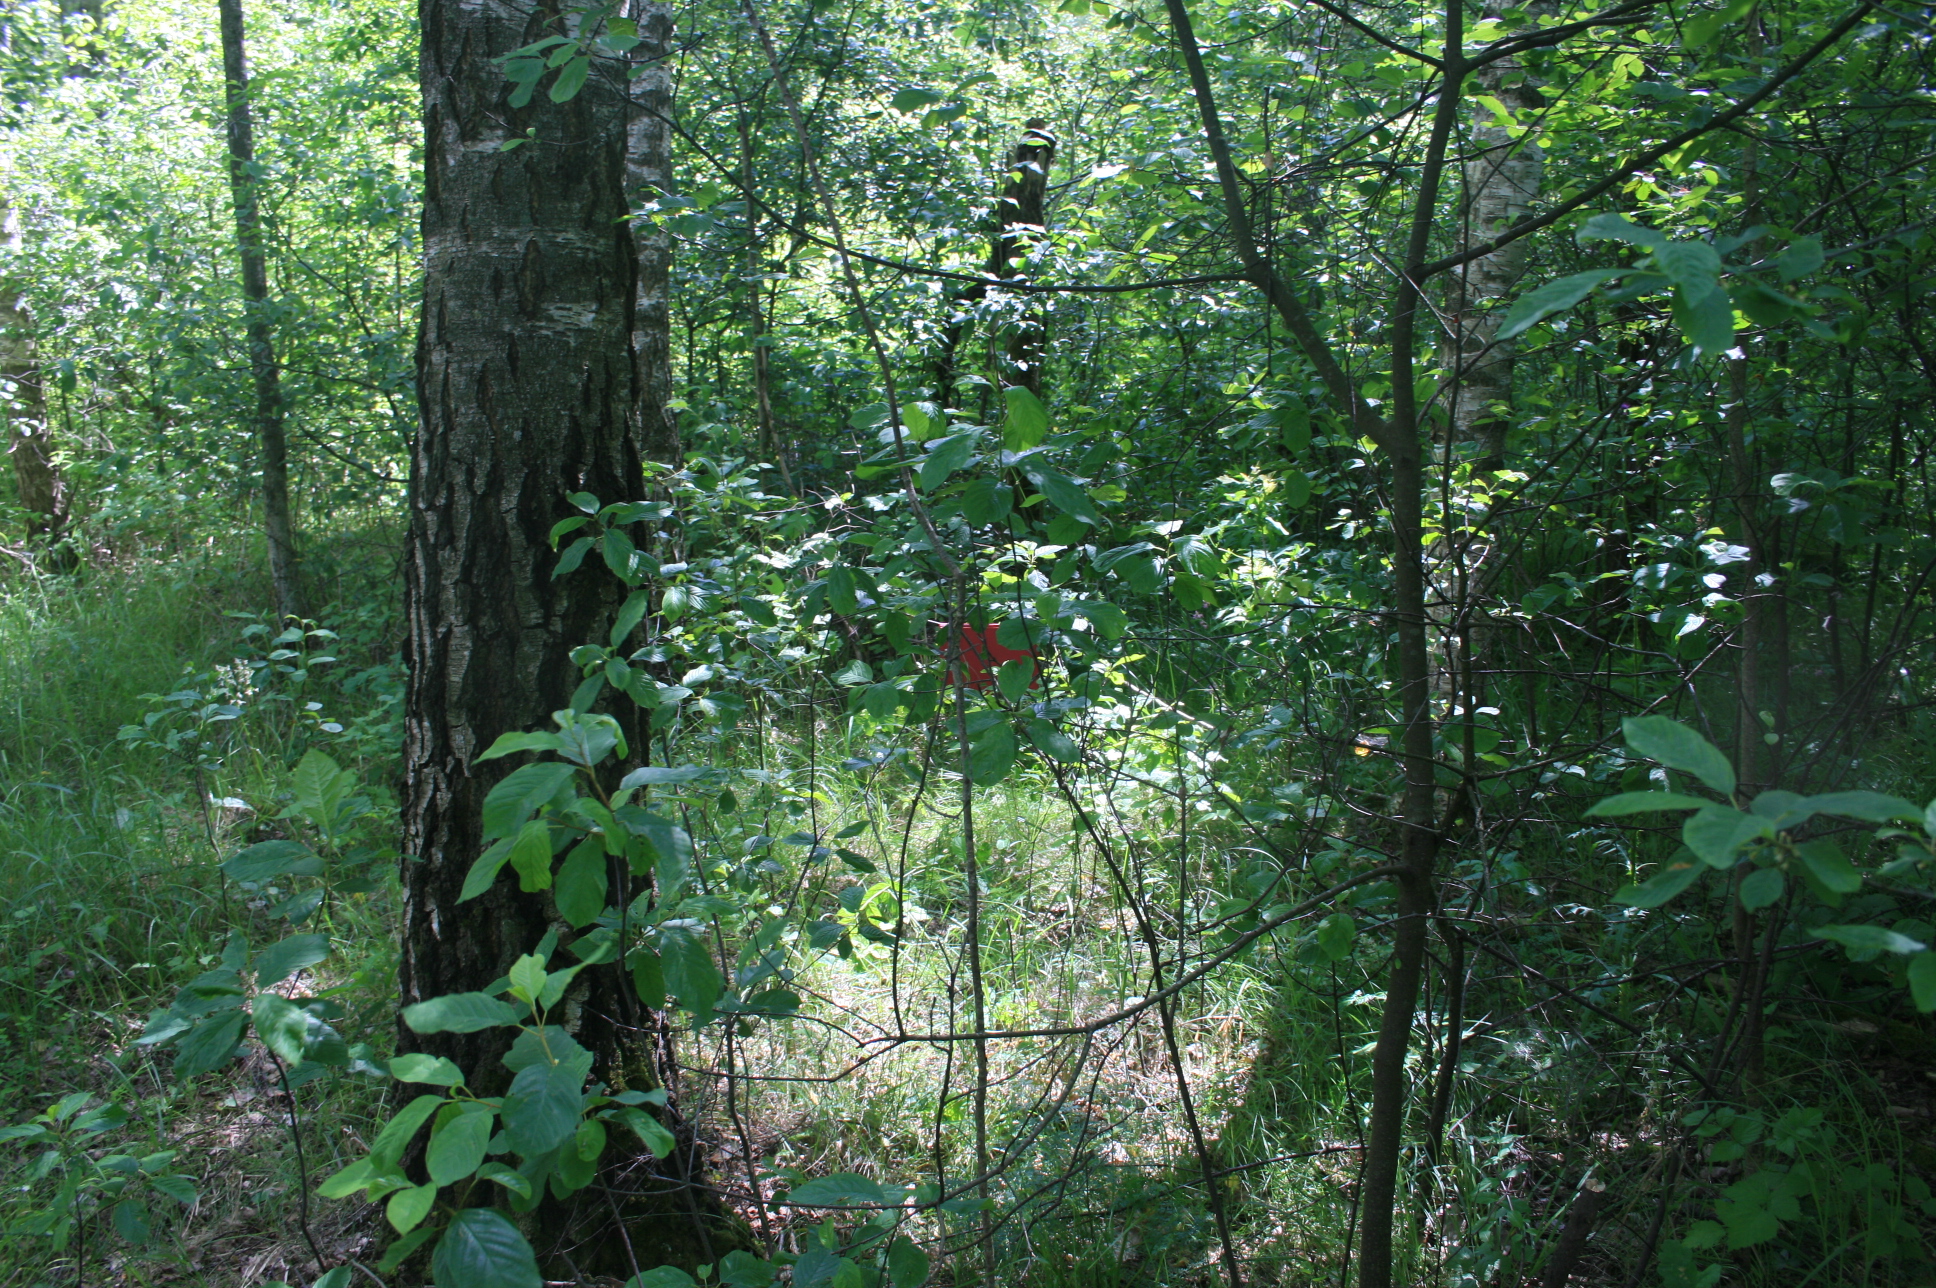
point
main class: Woodland
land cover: Broadleaved woodland
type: non-riverine alder, birch or aspen forest
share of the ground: > 75 %
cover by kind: broadleaved forest trees 90 %, herbaceous plants 10 %
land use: Forestry
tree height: > 5 m
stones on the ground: < 10 %
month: June
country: LT
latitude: 55.3324
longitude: 21.7945
